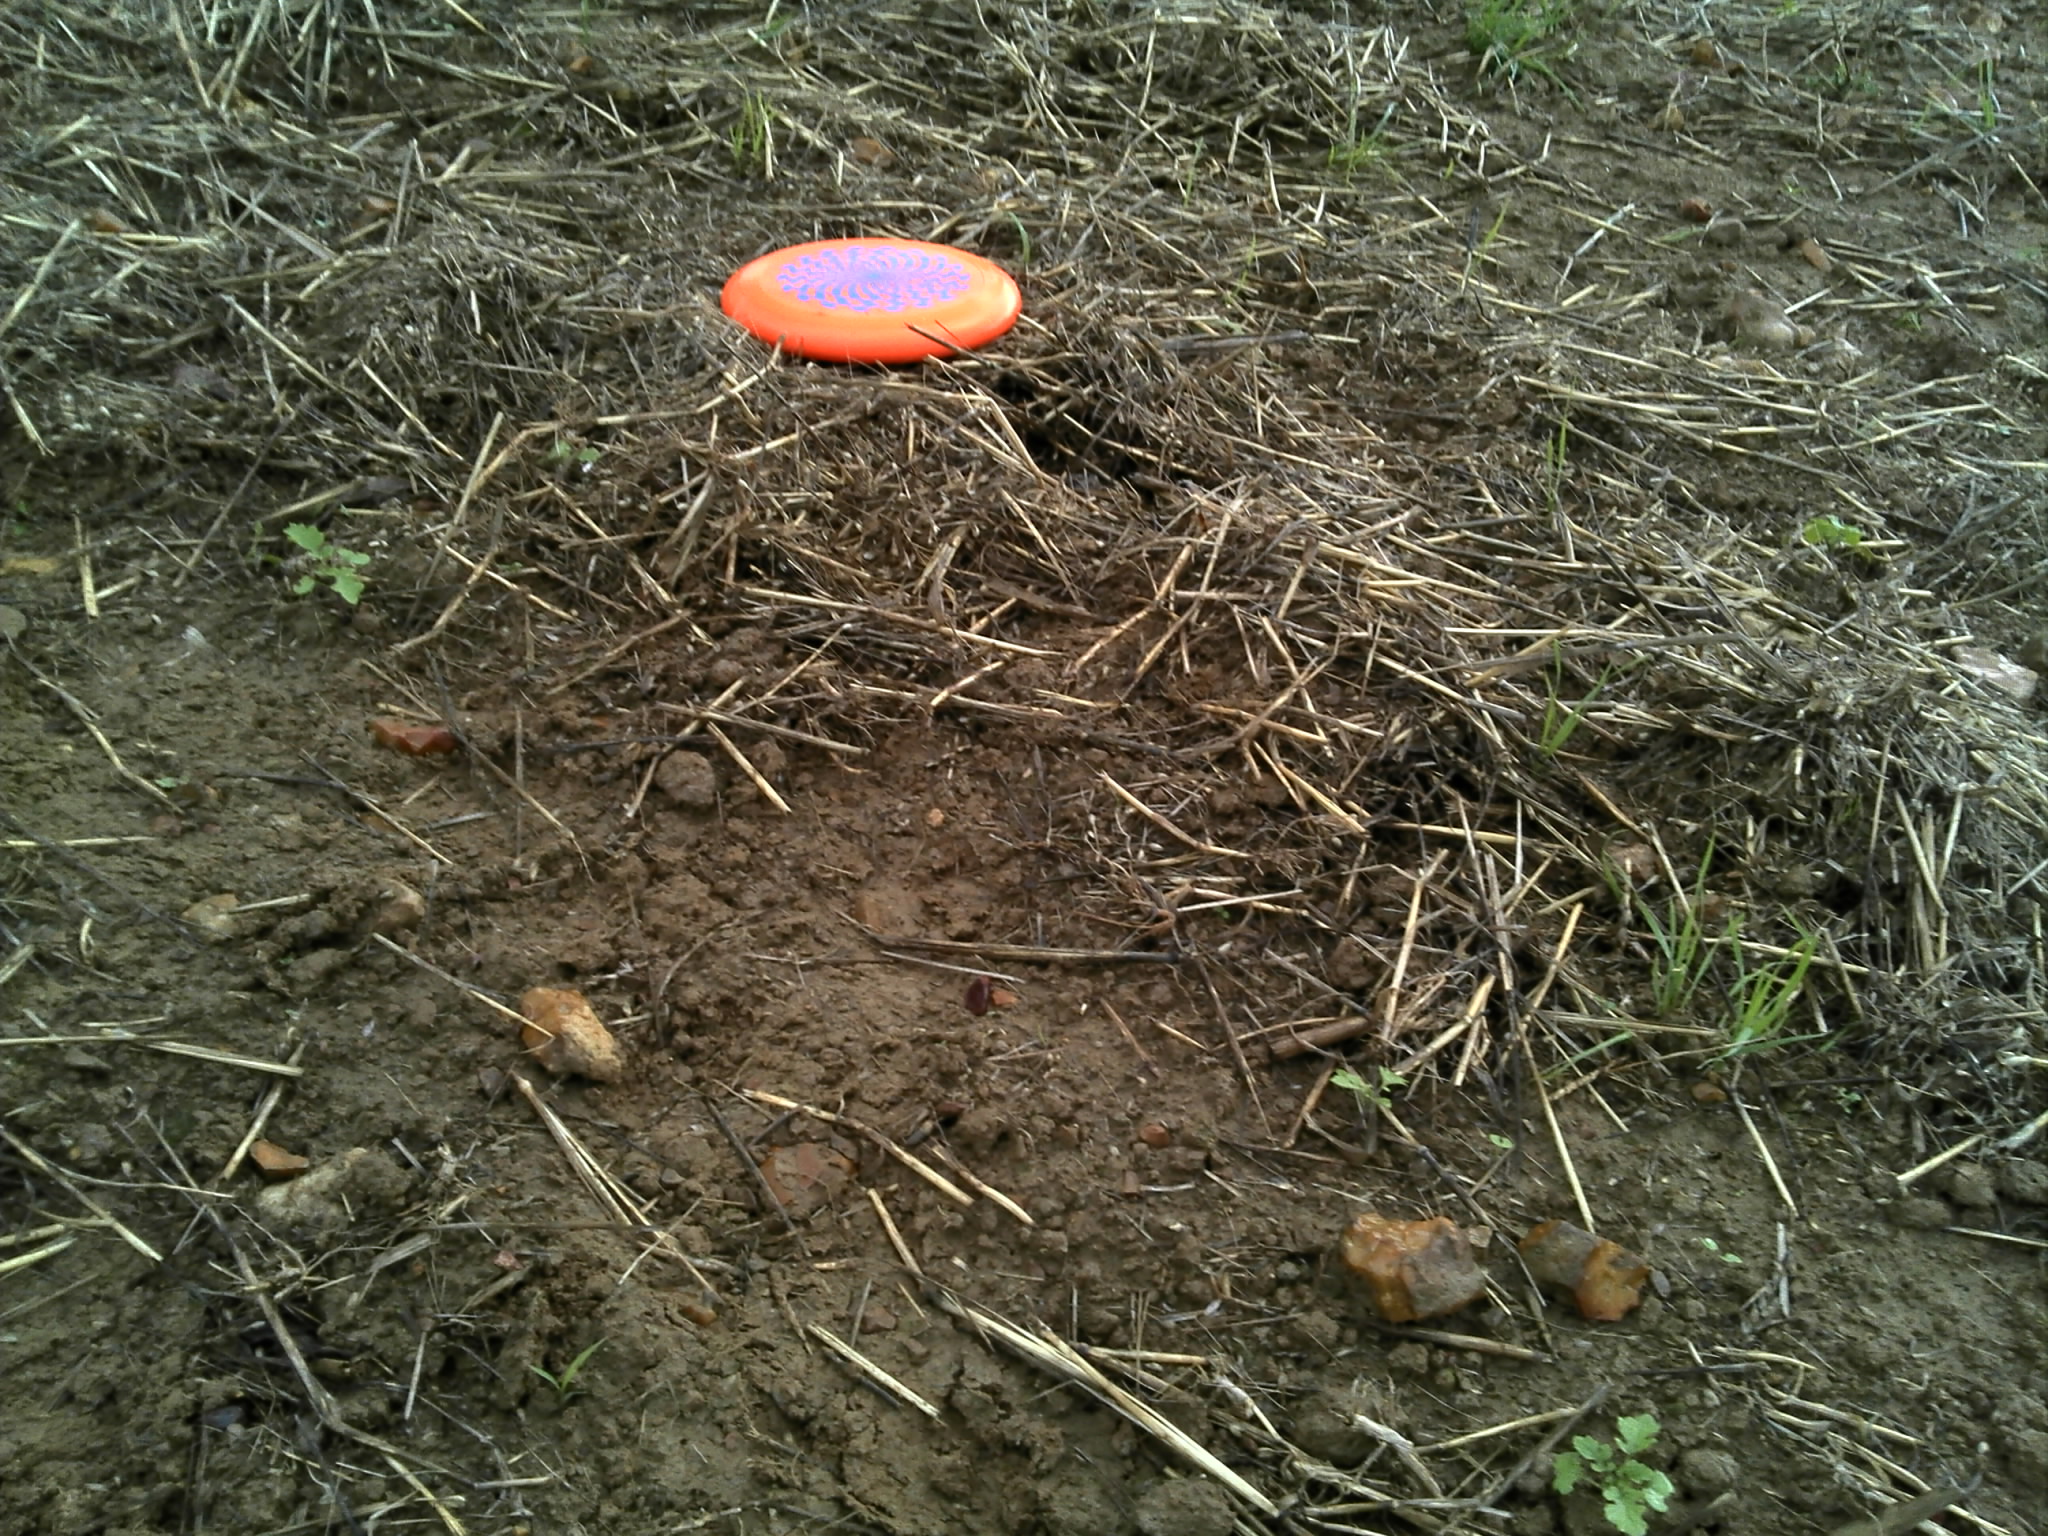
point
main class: Cropland
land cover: Common wheat
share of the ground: 10 - 25 %
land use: Agriculture (excluding fallow land and kitchen gardens)
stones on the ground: < 10 %
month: September
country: FR
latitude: 48.2393
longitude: 0.6189
